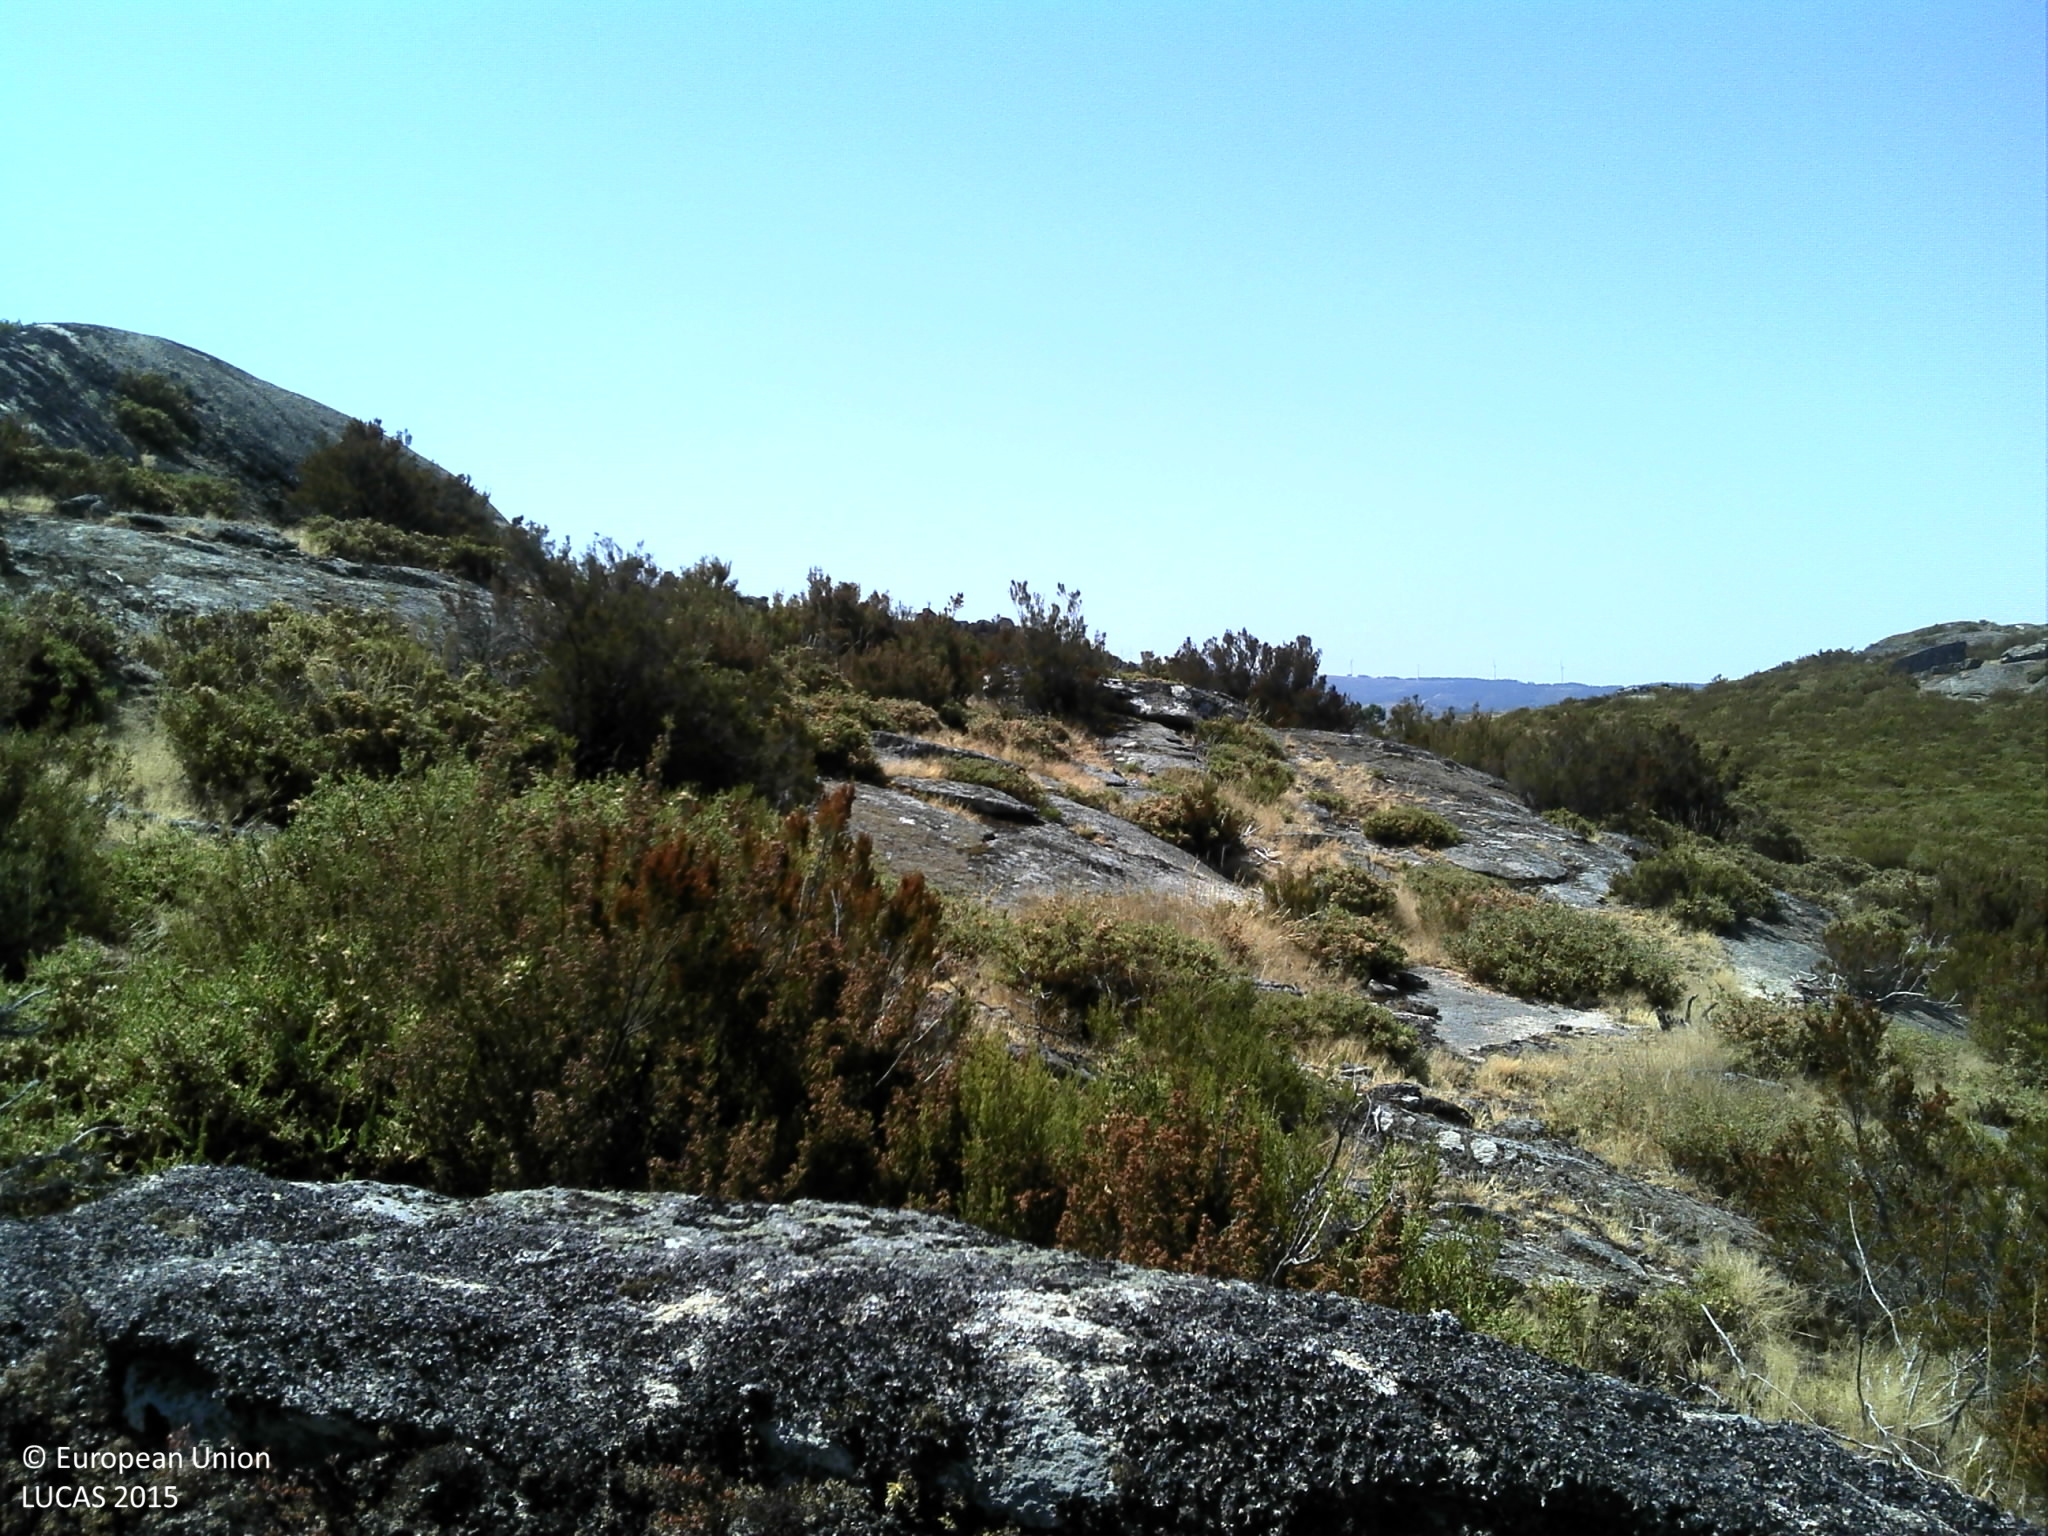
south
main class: Shrubland
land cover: Shrubland without tree cover
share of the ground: > 75 %
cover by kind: shrubs 75 %, consolidated bare surface 25 %
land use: Agriculture (excluding fallow land and kitchen gardens)
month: July
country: PT
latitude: 41.6748
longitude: -7.8817
